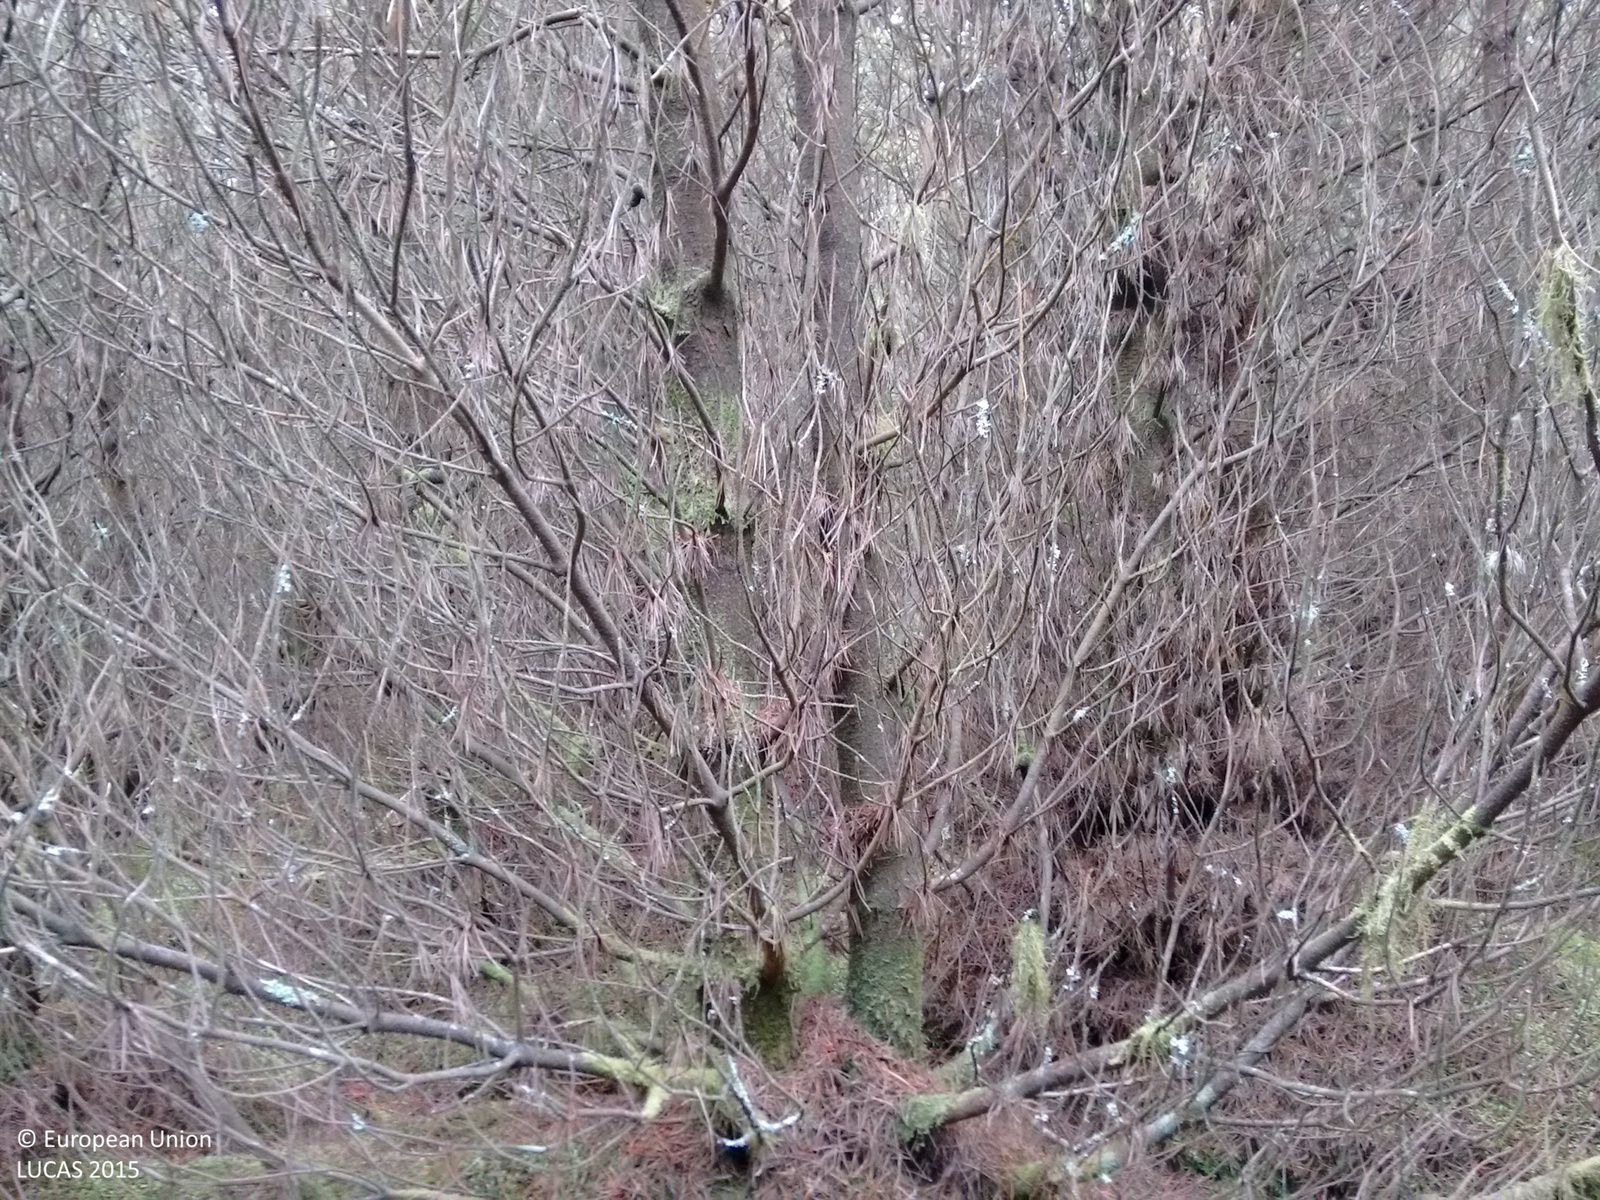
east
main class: Woodland
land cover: Pine dominated coniferous woodland
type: exotic forest
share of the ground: > 75 %
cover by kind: coniferous forest trees 100 %
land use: Forestry
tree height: > 5 m
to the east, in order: Pine dominated coniferous woodland; Grass margins; Pine dominated coniferous woodland
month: August
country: GB
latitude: 58.6245
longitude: -3.1973
